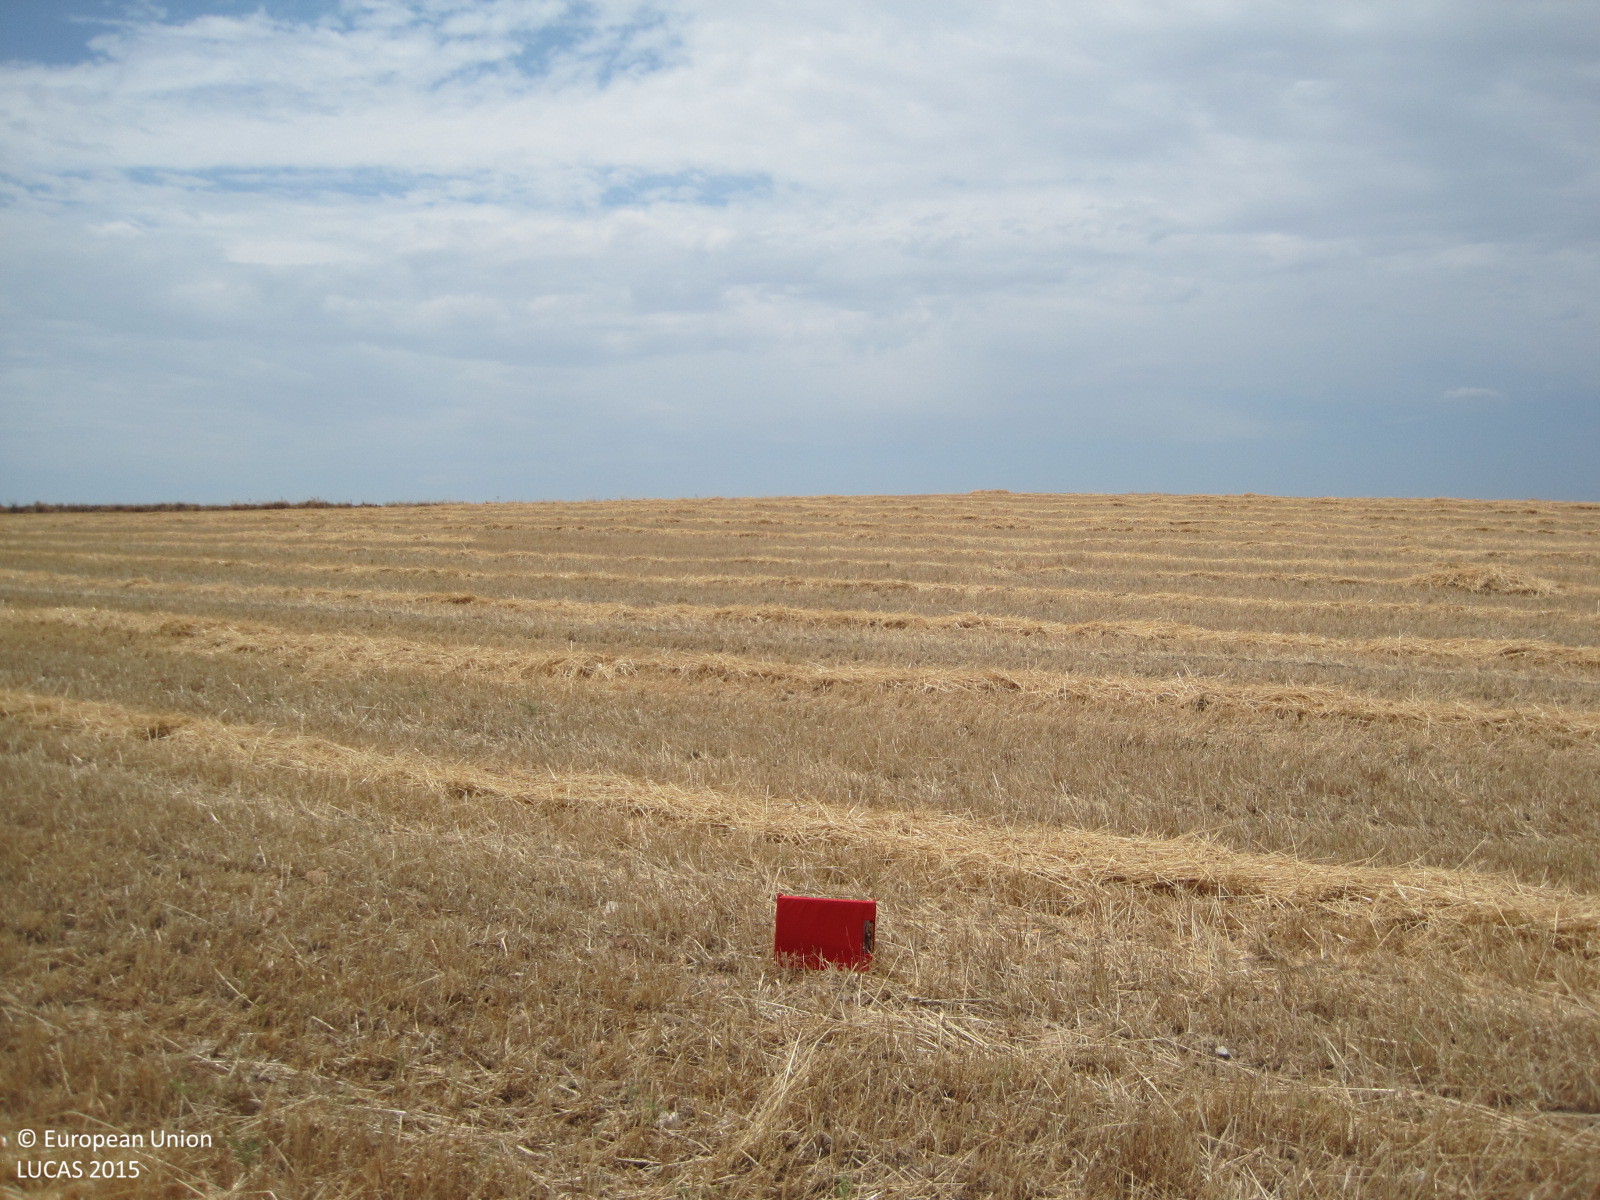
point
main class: Cropland
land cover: Common wheat
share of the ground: < 10 %
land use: Agriculture (excluding fallow land and kitchen gardens)
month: July
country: ES
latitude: 40.1027
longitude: -4.3660
